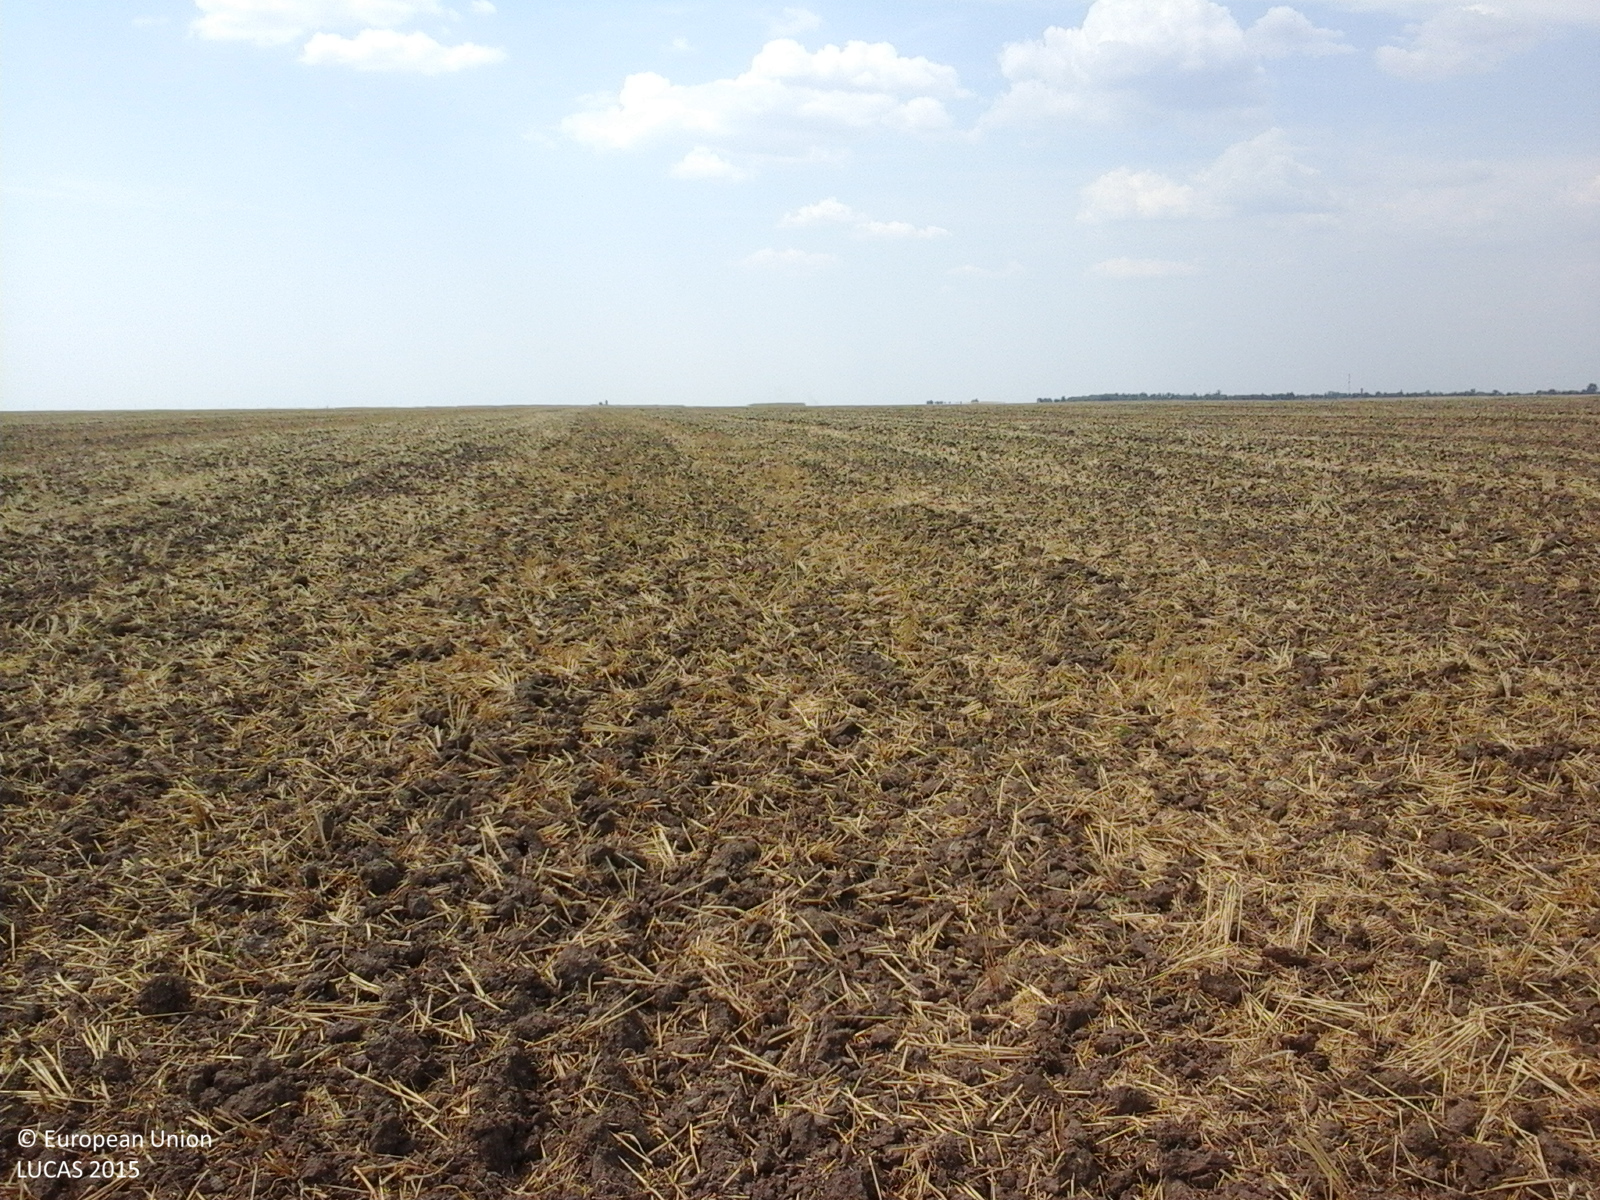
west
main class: Cropland
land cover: Common wheat
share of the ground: 25 - 50 %
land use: Agriculture (excluding fallow land and kitchen gardens)
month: August
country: RO
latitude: 44.1536
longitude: 23.1102
